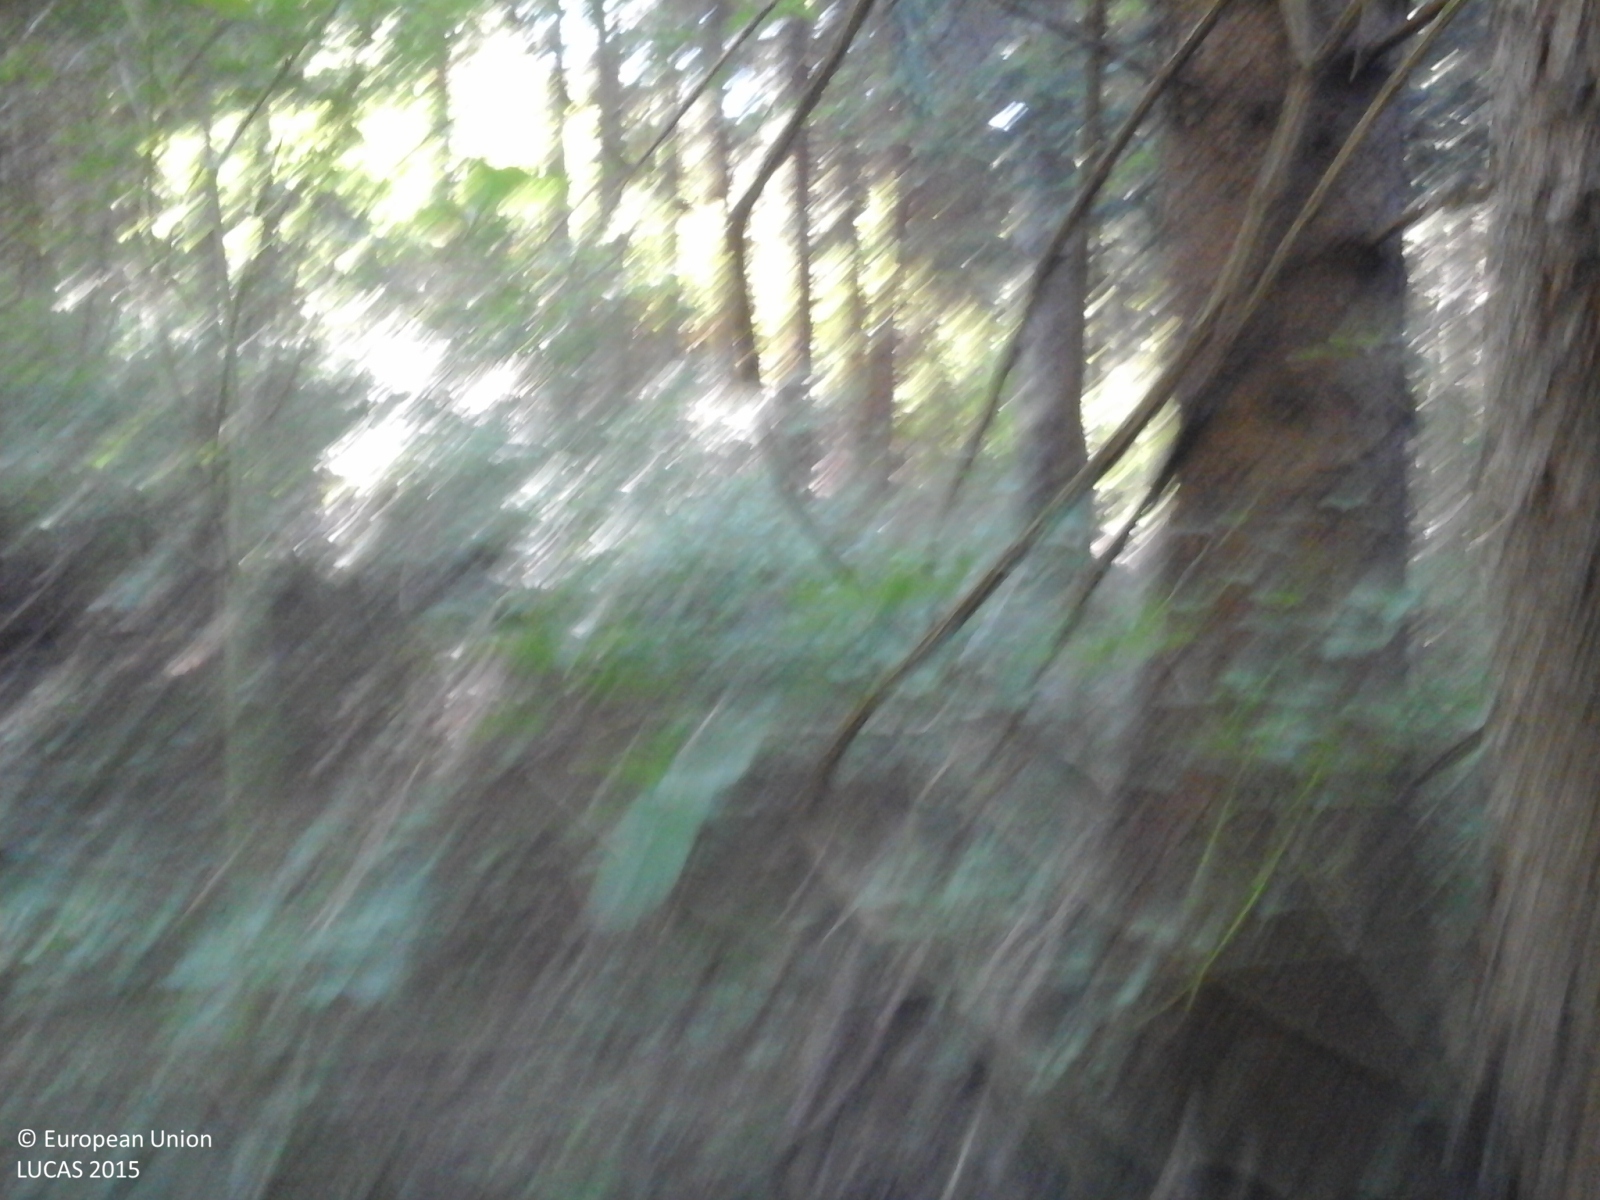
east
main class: Woodland
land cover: Spruce dominated coniferous woodland
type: alpine coniferous forest
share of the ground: > 75 %
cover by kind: coniferous forest trees 100 %
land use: Forestry
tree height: > 5 m
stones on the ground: 10 - 25 %
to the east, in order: Spruce dominated coniferous woodland; Paved roads, cycling and walking lanes; Spruce dominated coniferous woodland; Tracks; Spruce dominated coniferous woodland
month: May
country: IT
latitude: 46.1486
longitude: 10.9697
